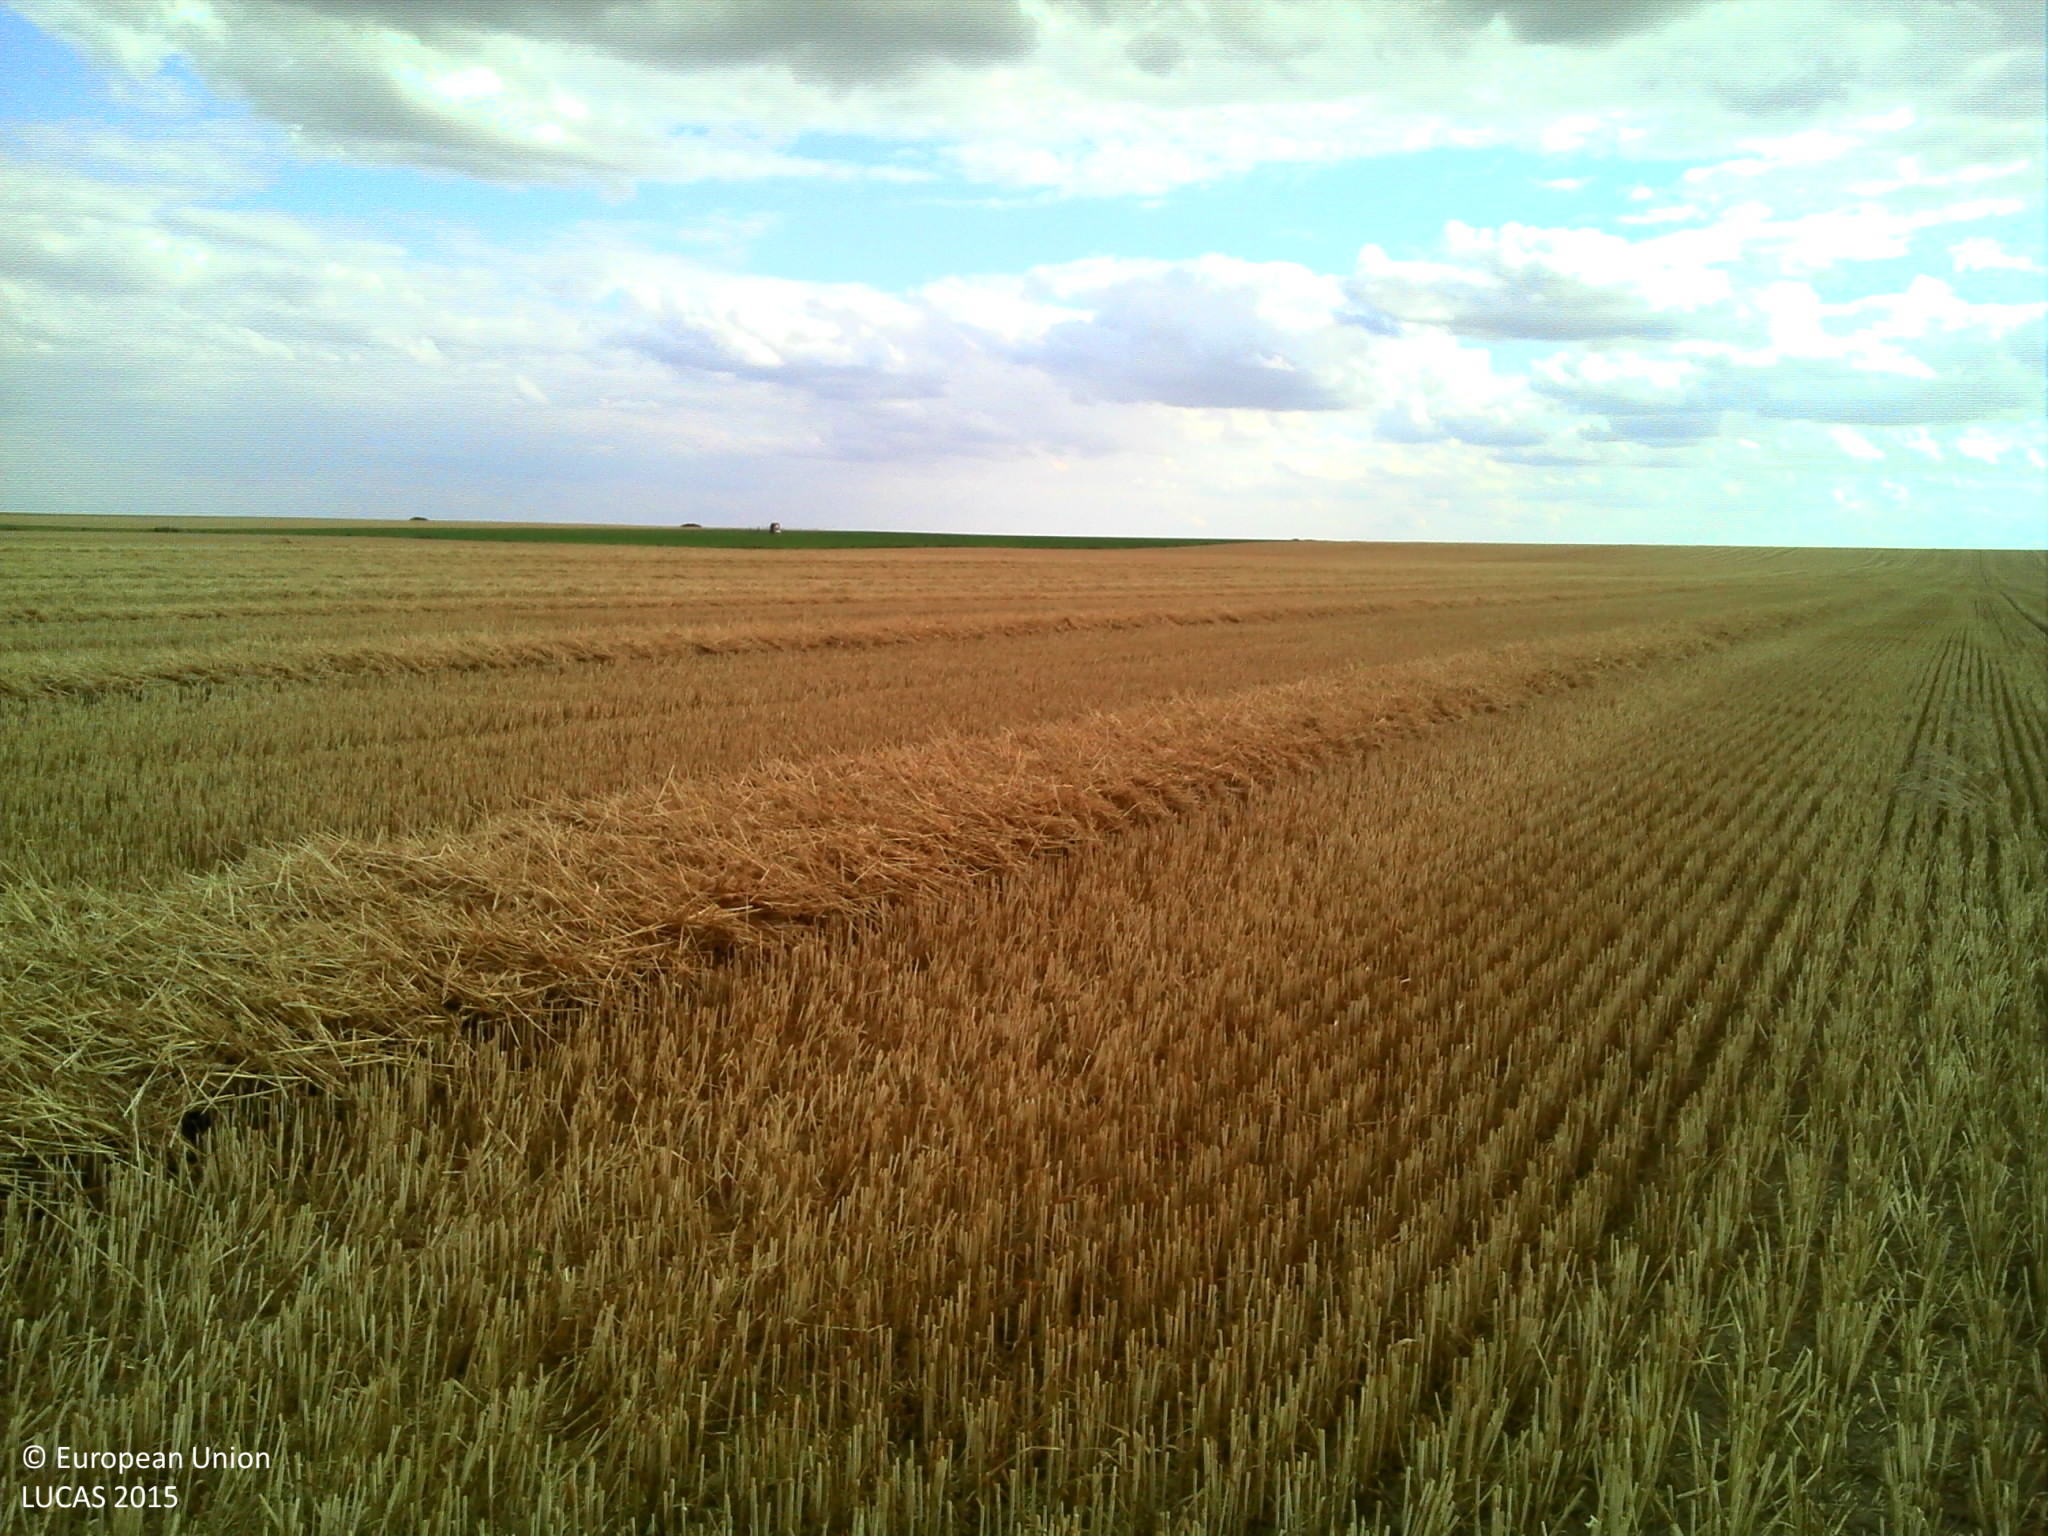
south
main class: Cropland
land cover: Common wheat
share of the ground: > 75 %
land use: Agriculture (excluding fallow land and kitchen gardens)
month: July
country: FR
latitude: 49.0868
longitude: 4.3136
